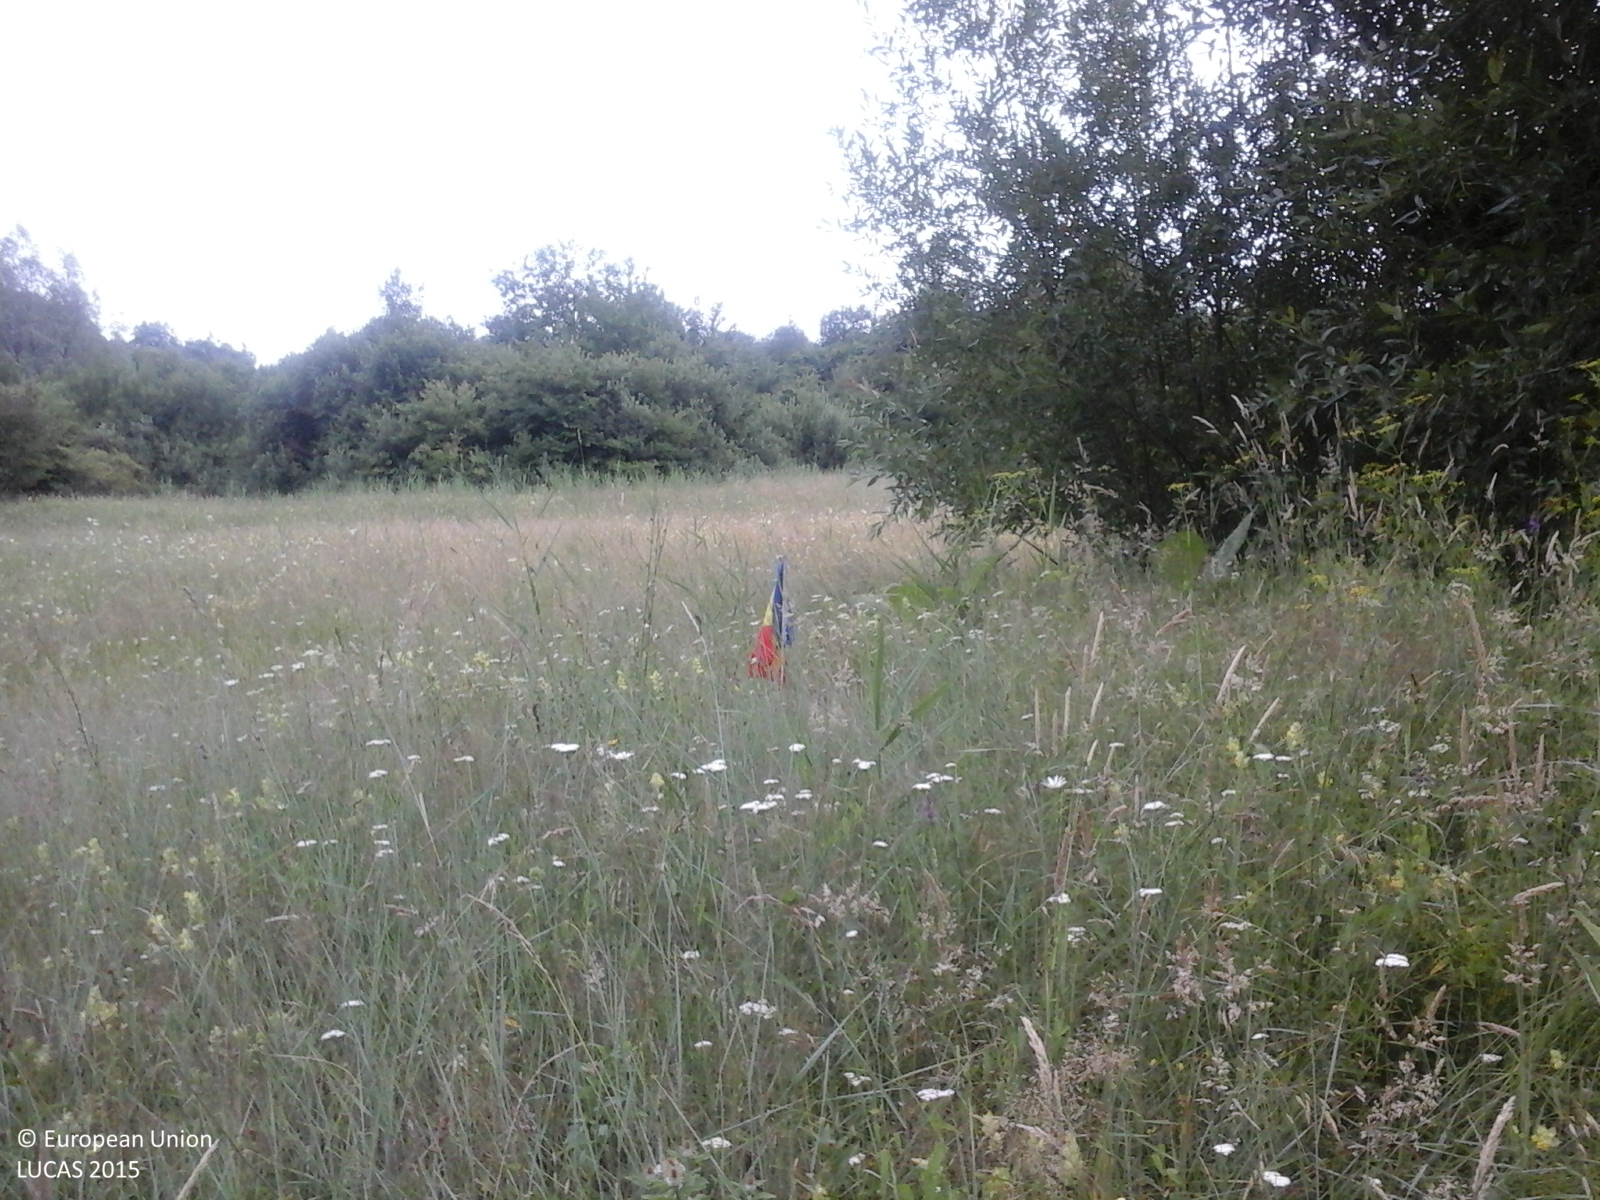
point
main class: Grassland
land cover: Grassland with sparse tree/shrub cover
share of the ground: > 75 %
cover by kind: herbaceous plants 90 %, broadleaved forest trees 5 %, shrubs 5 %
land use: Agriculture (excluding fallow land and kitchen gardens)
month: July
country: RO
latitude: 45.1924
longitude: 24.7582
